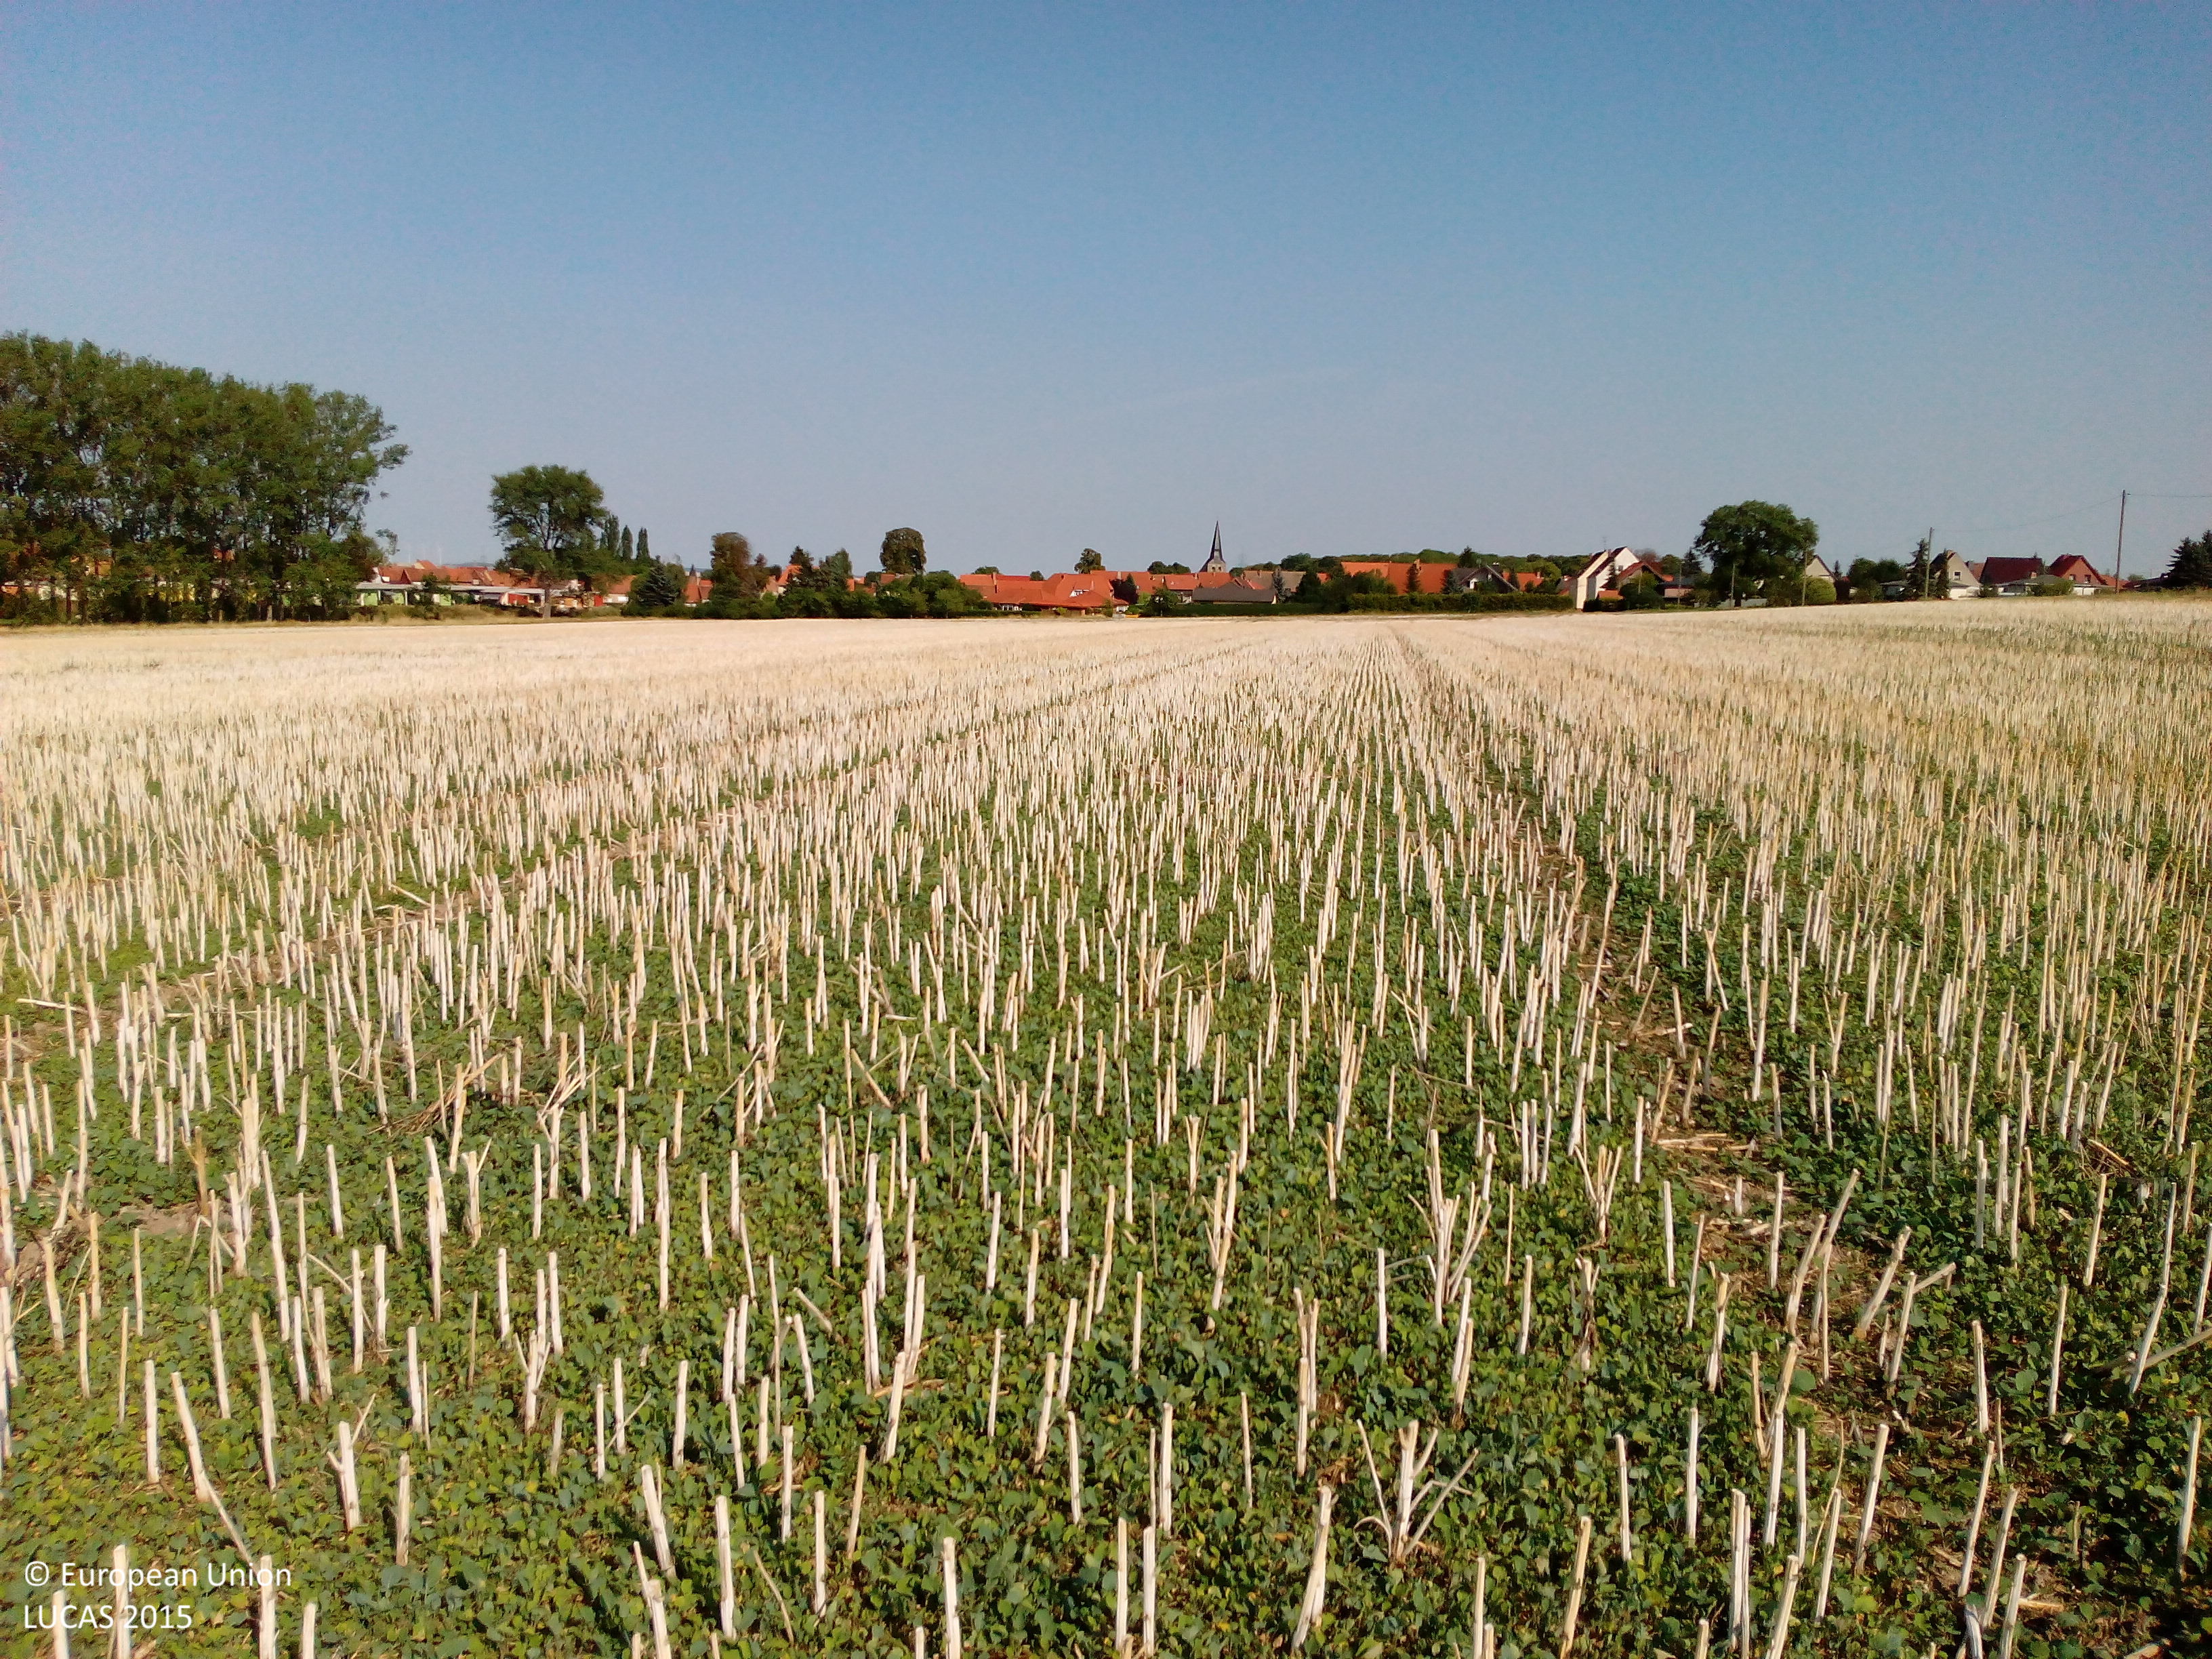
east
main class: Cropland
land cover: Rape and turnip rape
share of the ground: 10 - 25 %
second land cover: Other root crops
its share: 50 - 75 %
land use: Agriculture (excluding fallow land and kitchen gardens)
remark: Harvested field
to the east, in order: Rape and turnip rape; Other root crops
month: August
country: DE
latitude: 51.8691
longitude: 11.0889
